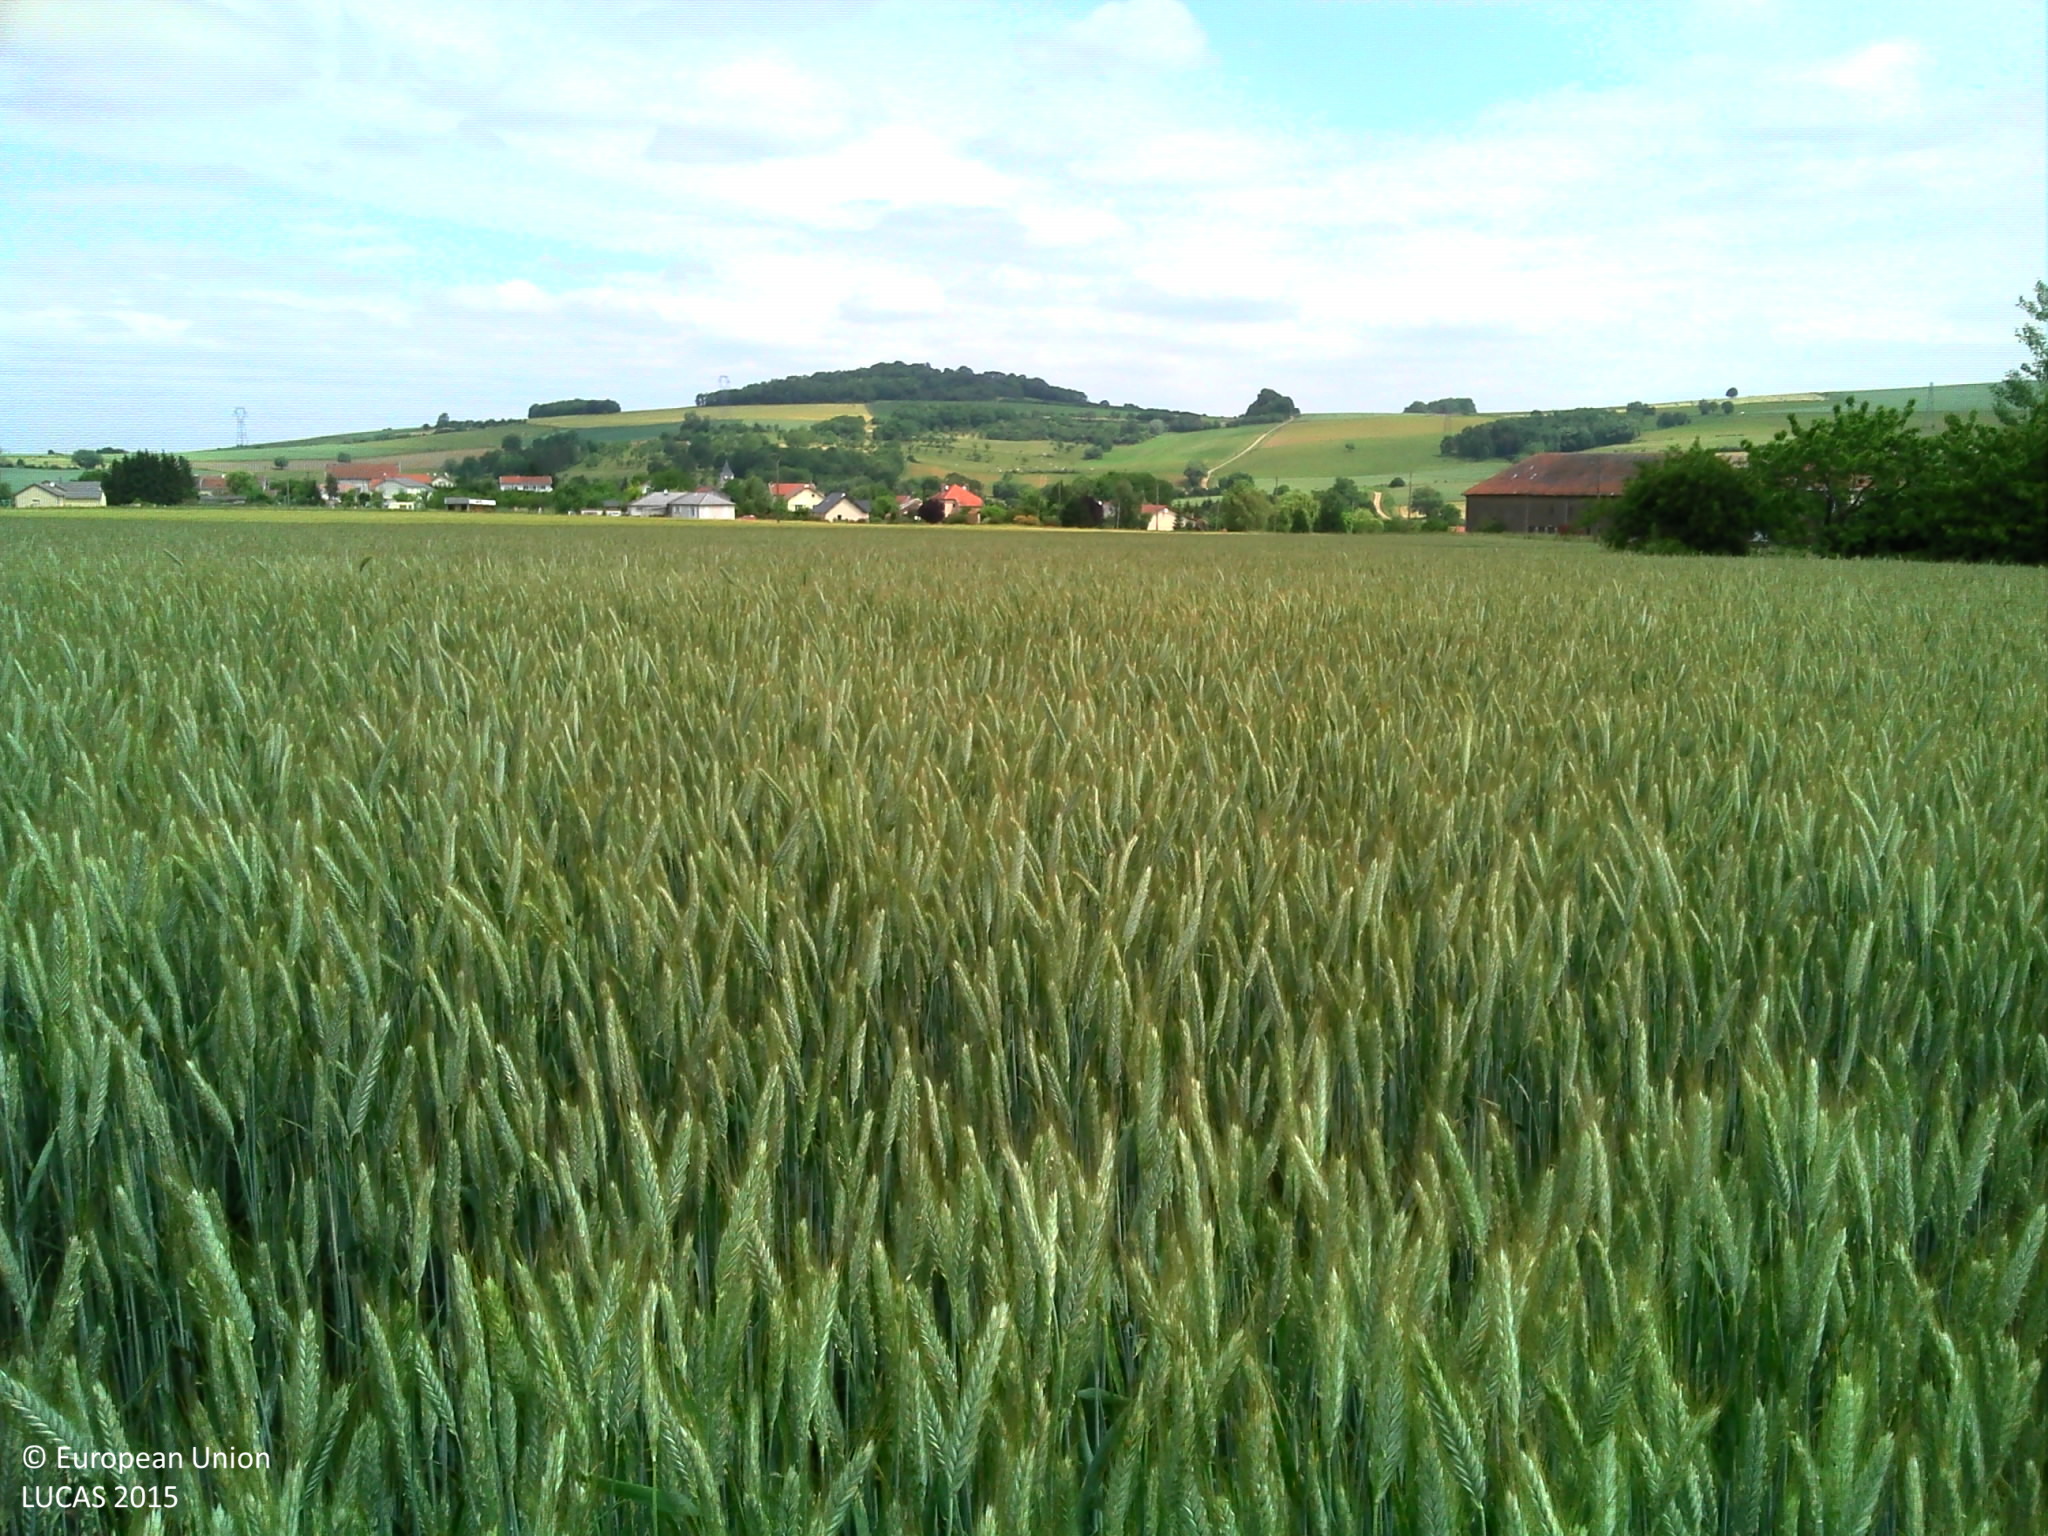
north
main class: Cropland
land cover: Triticale
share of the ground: > 75 %
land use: Agriculture (excluding fallow land and kitchen gardens)
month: June
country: FR
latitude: 48.8245
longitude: 6.1997
